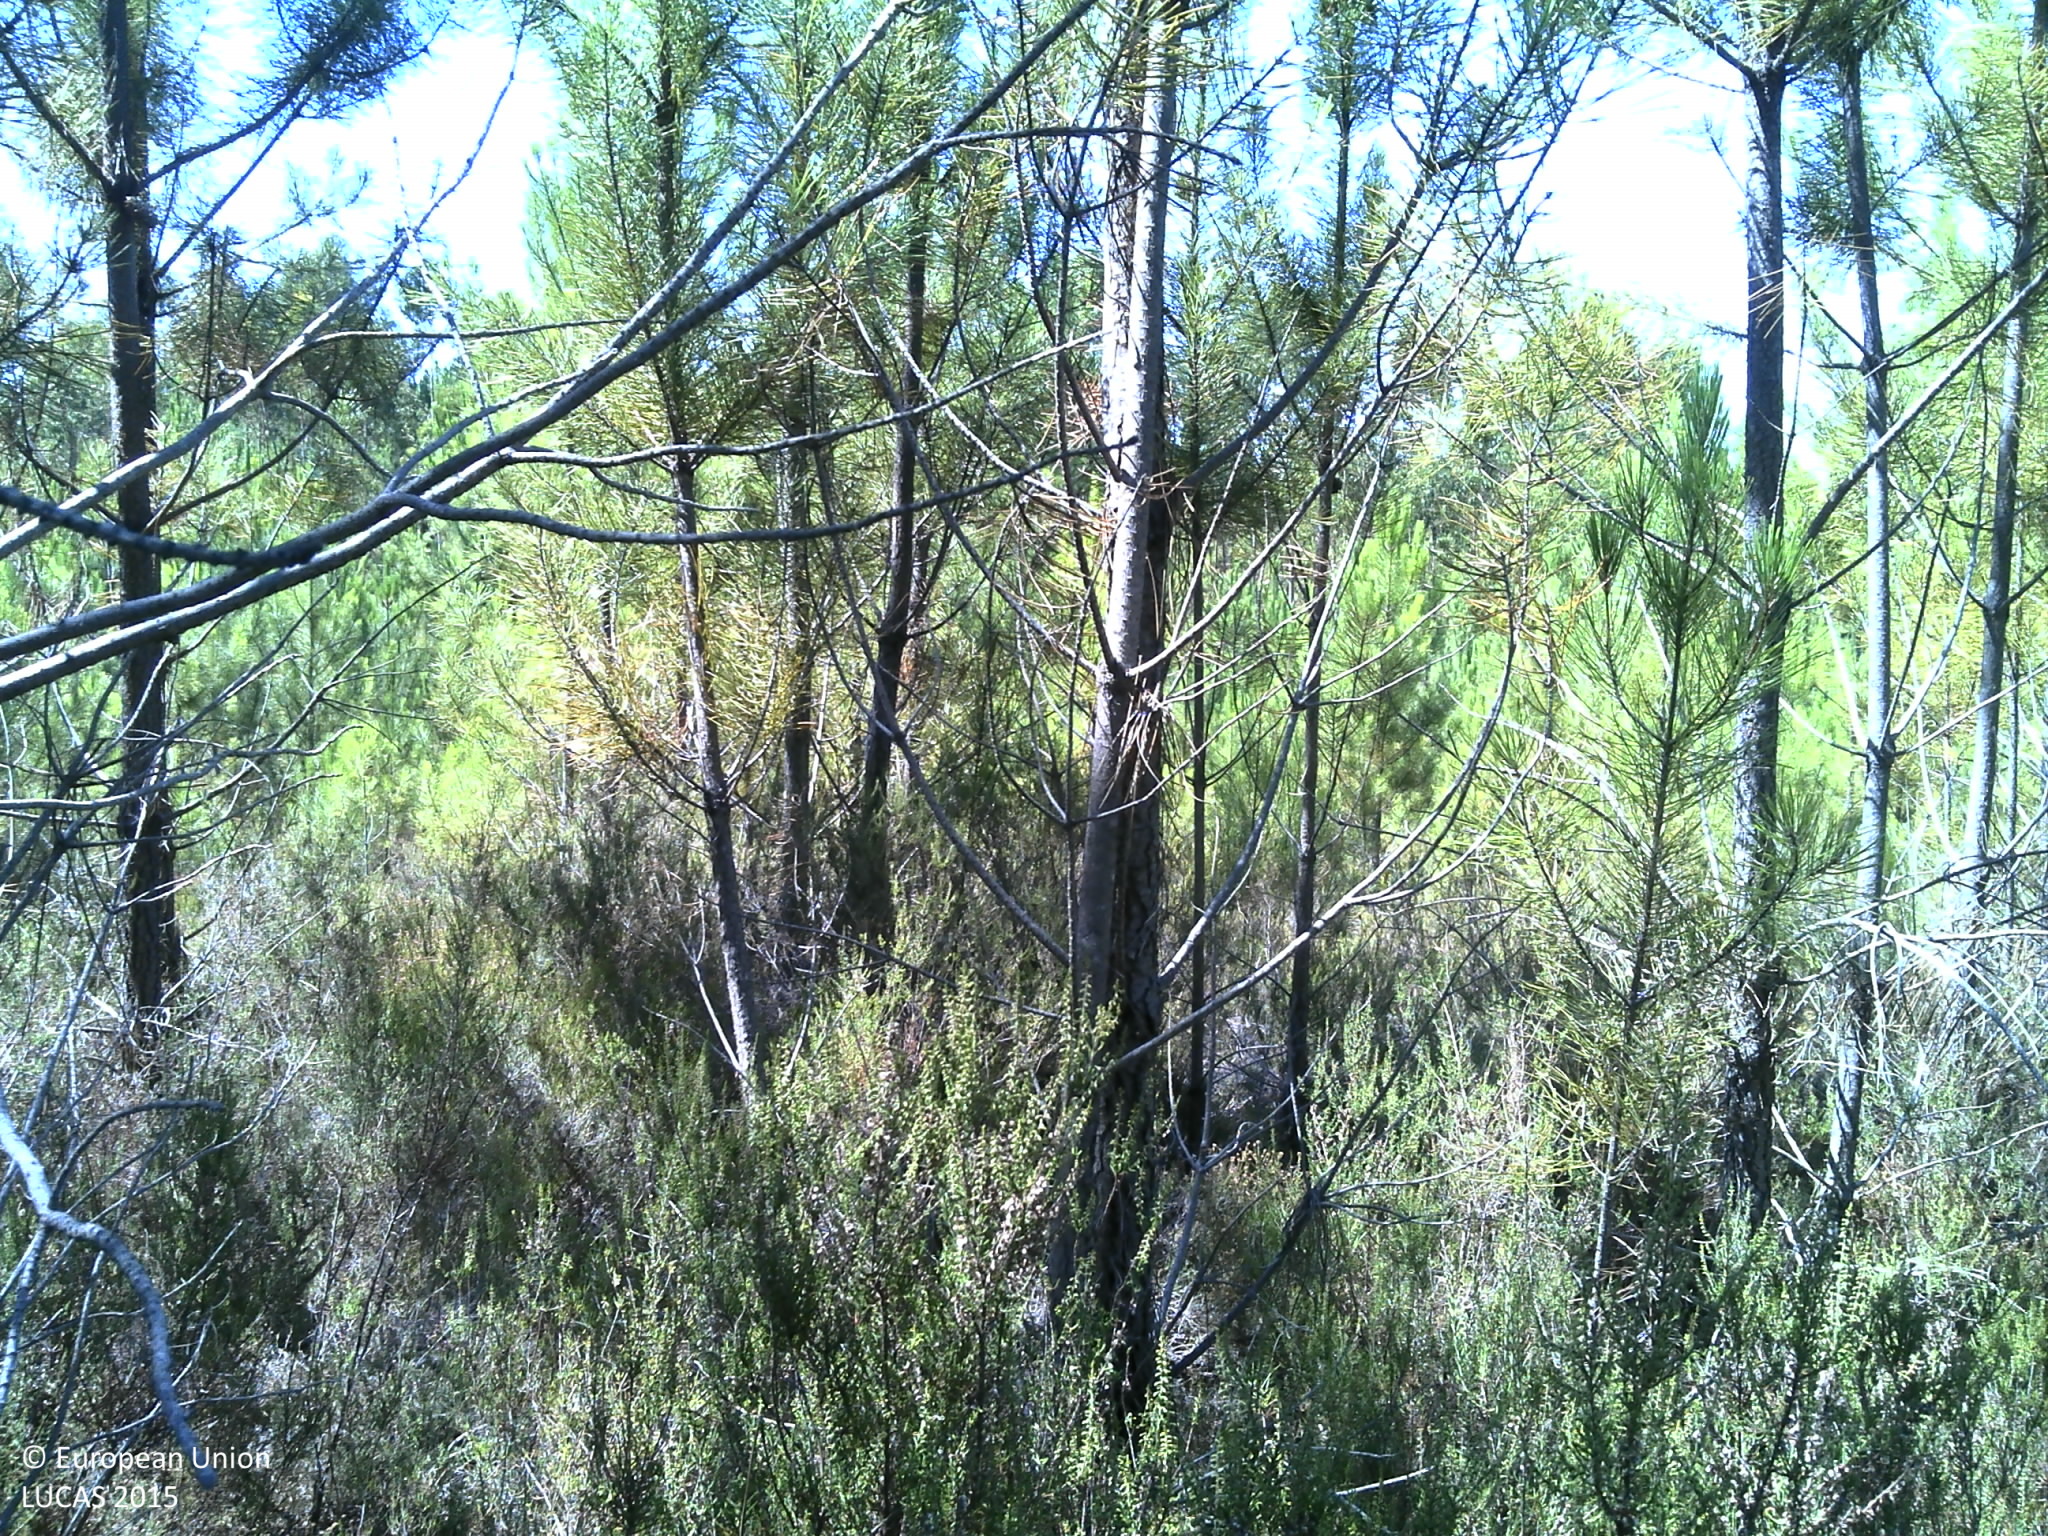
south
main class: Woodland
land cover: Pine dominated coniferous woodland
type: coniferous forest of the mediterranean region
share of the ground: 50 - 75 %
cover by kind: coniferous forest trees 50 %, shrubs 40 %, unconsolidated bare surface 10 %
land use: Forestry
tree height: < 5 m
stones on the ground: > 50 %
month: July
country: PT
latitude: 39.7848
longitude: -7.8200
